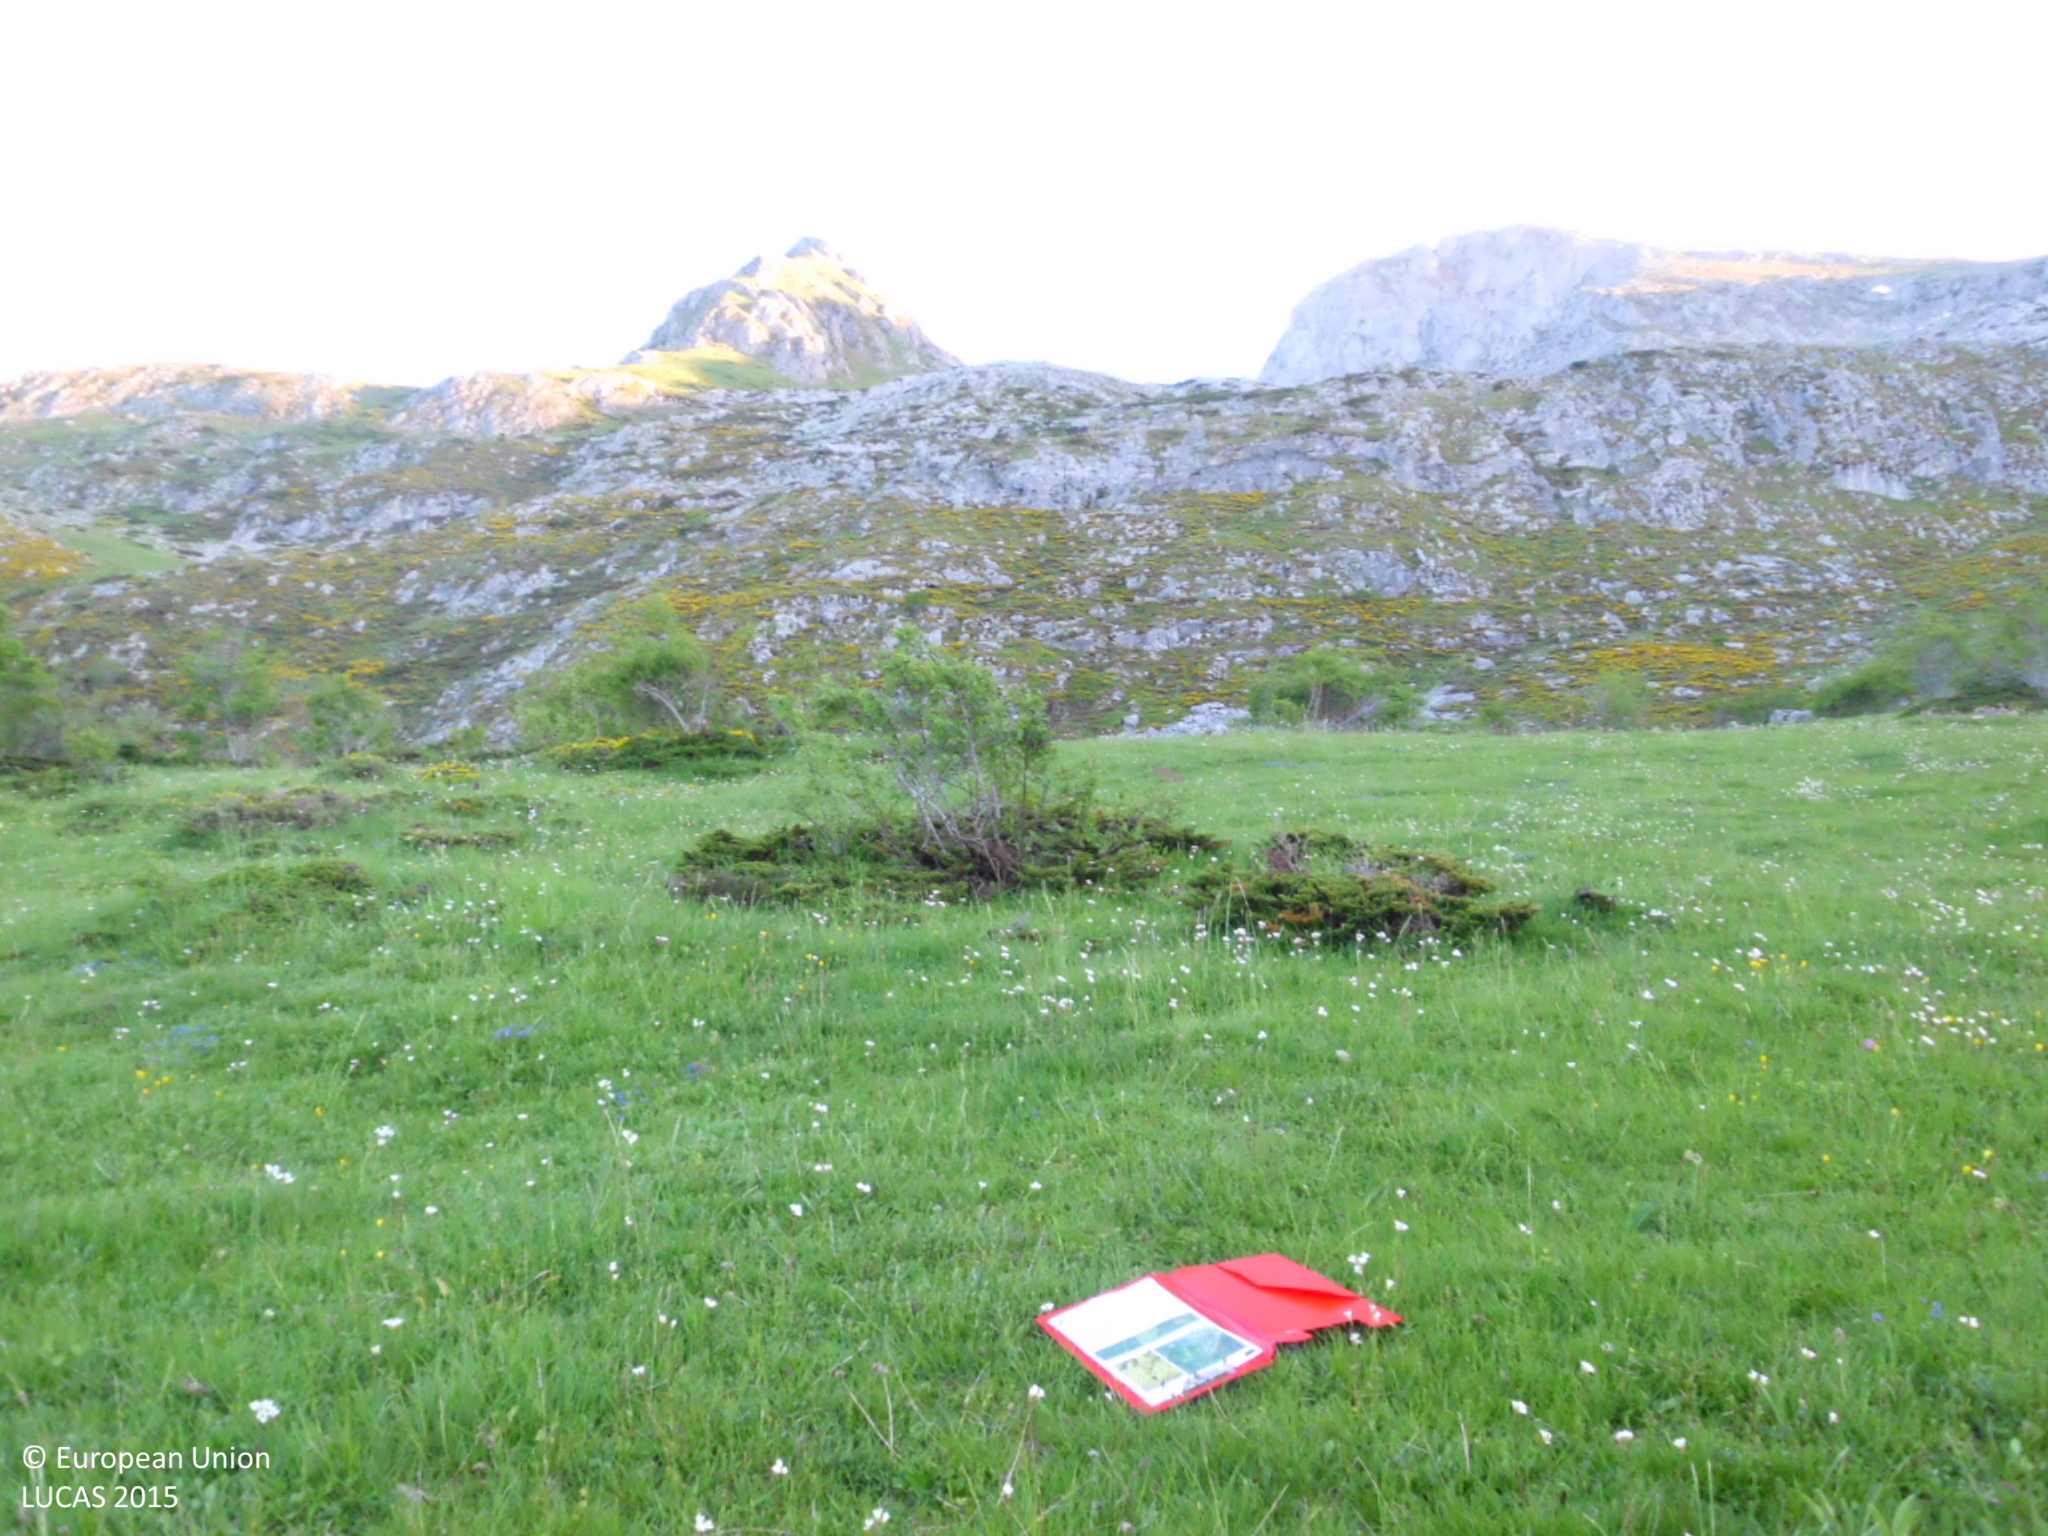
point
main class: Grassland
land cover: Grassland without tree/shrub cover
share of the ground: > 75 %
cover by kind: herbaceous plants 100 %
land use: Agriculture (excluding fallow land and kitchen gardens)
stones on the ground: < 10 %
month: May
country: ES
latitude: 43.0426
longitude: -5.1807
